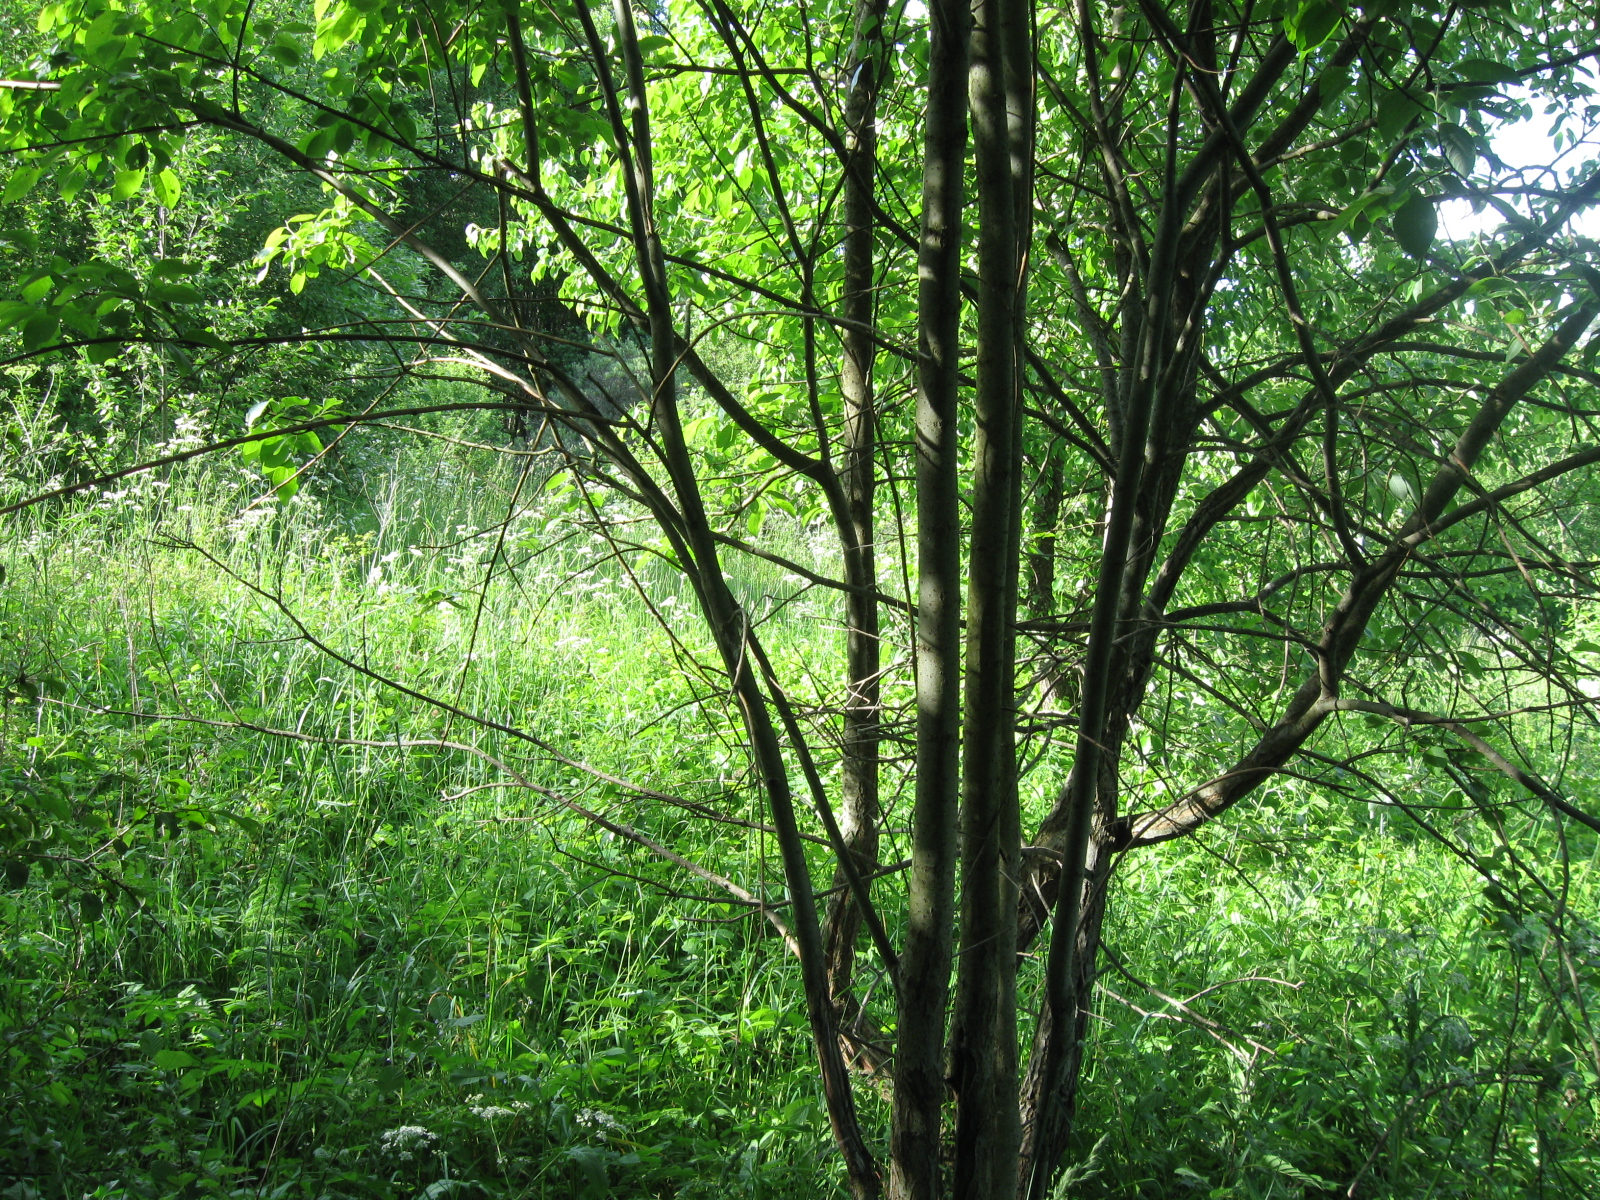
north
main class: Woodland
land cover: Broadleaved woodland
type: non-riverine alder, birch or aspen forest
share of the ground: 50 - 75 %
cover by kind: broadleaved forest trees 65 %, herbaceous plants 35 %
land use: Forestry
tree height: > 5 m
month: June
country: LT
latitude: 54.9926
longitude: 24.0176
